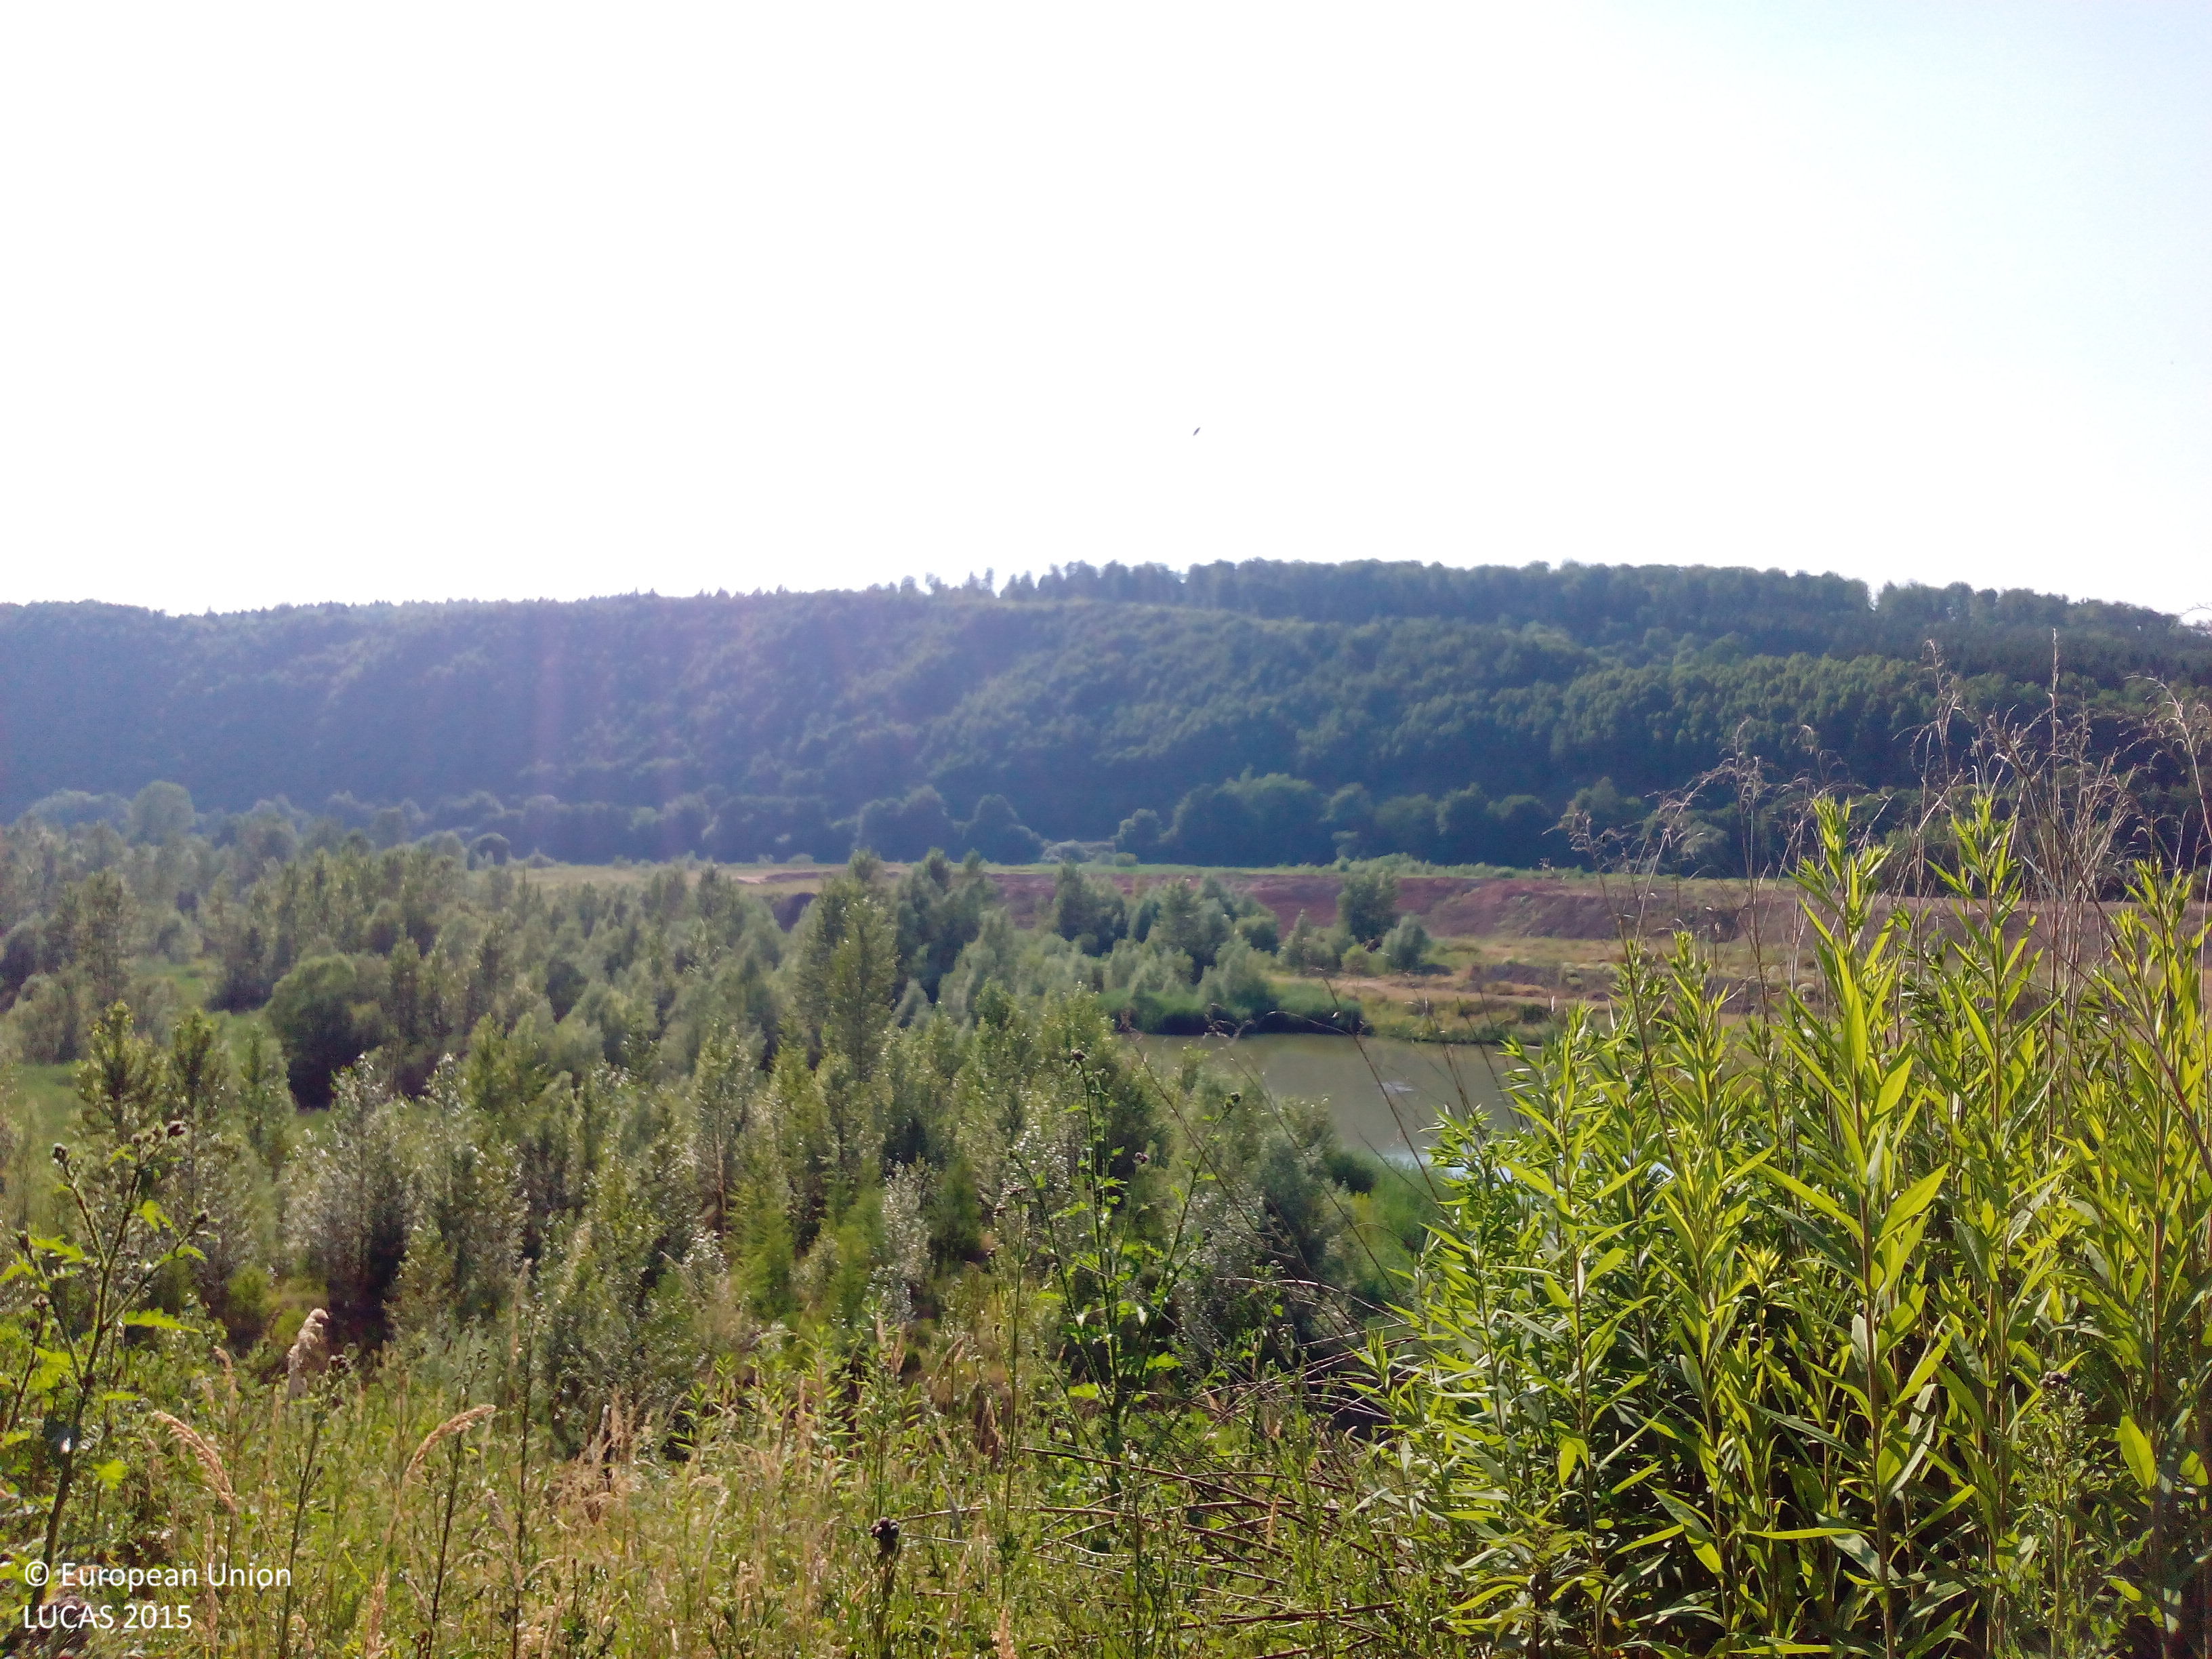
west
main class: Woodland
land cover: Broadleaved woodland
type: non-riverine alder, birch or aspen forest
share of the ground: > 75 %
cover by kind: broadleaved forest trees 75 %, herbaceous plants 15 %, shrubs 10 %
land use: Mining and quarrying
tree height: > 5 m
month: July
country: DE
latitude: 51.4602
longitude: 9.6403
